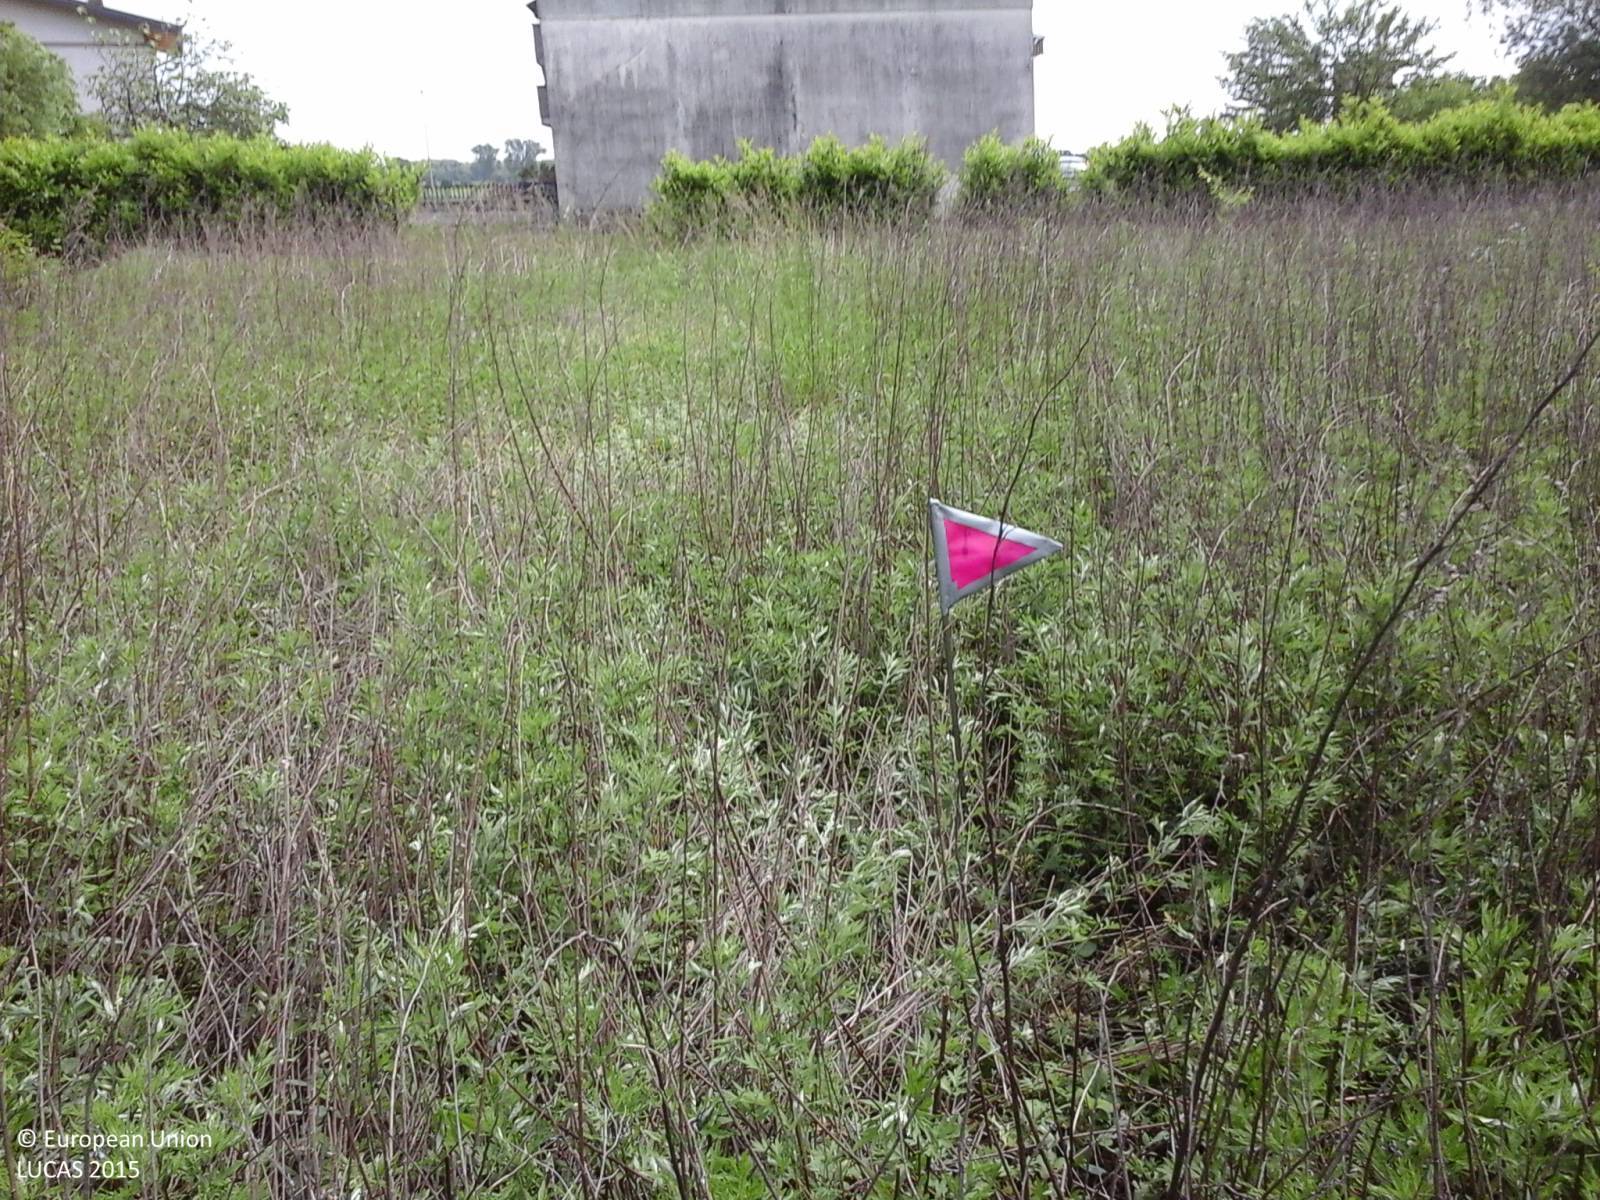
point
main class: Grassland
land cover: Spontaneously vegetated surfaces
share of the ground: > 75 %
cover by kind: herbaceous plants 100 %
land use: Fallow land
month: May
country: IT
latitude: 46.0302
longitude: 13.2908
